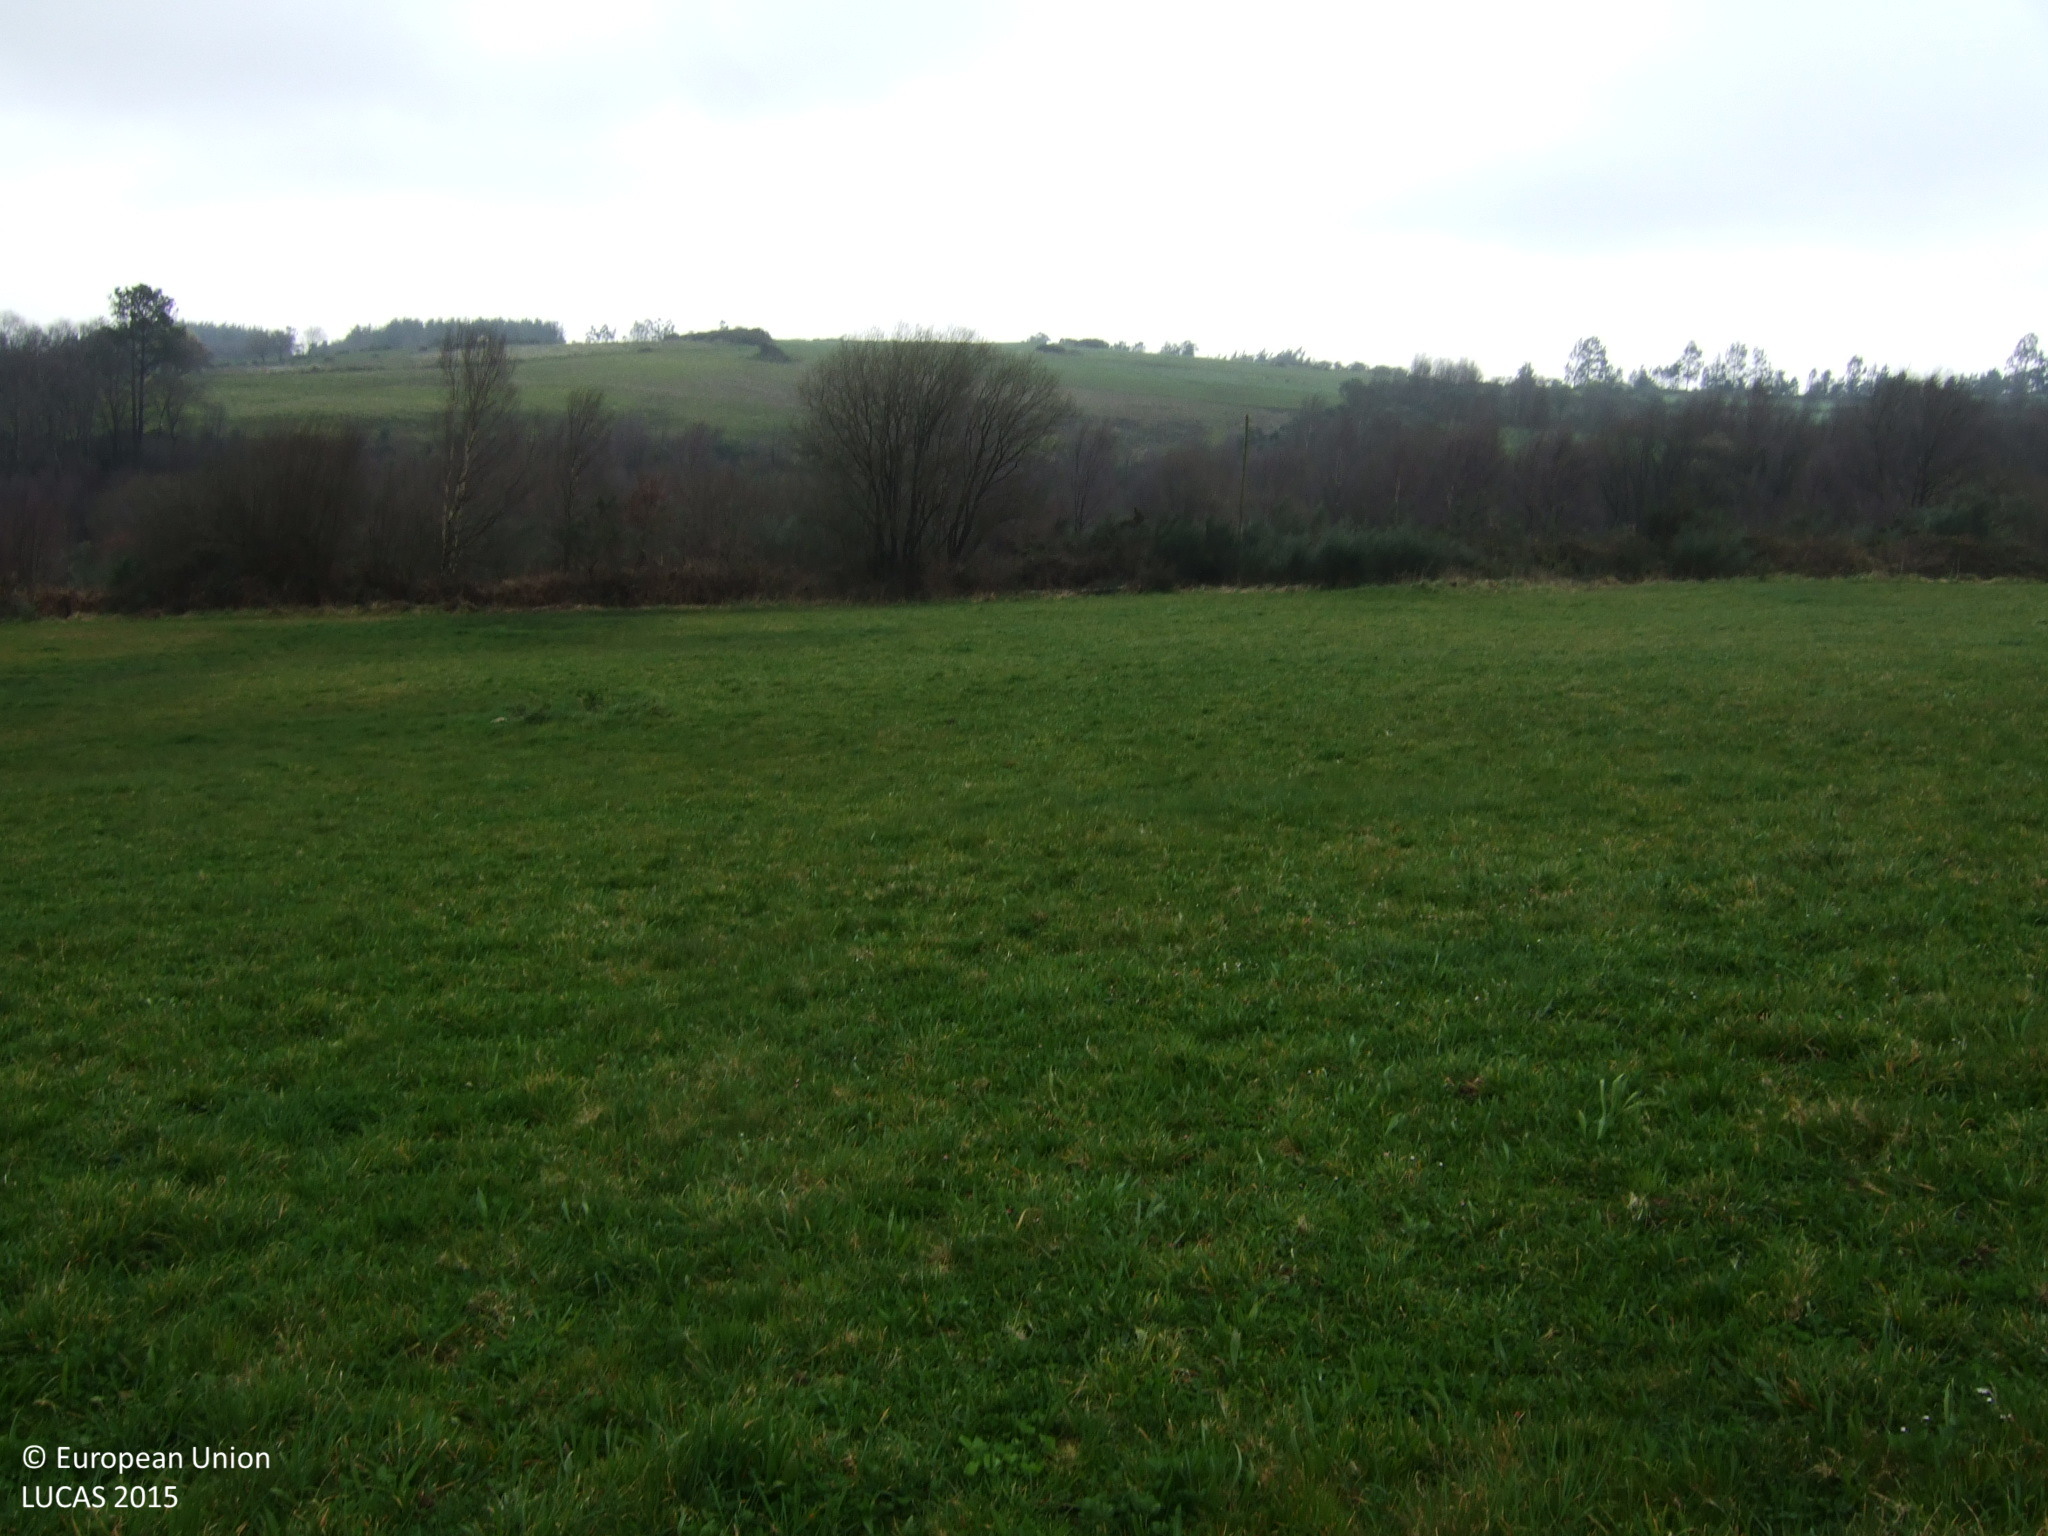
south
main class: Grassland
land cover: Grassland without tree/shrub cover
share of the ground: > 75 %
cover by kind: herbaceous plants 100 %
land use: Agriculture (excluding fallow land and kitchen gardens)
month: March
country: ES
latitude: 42.9540
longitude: -7.8460
